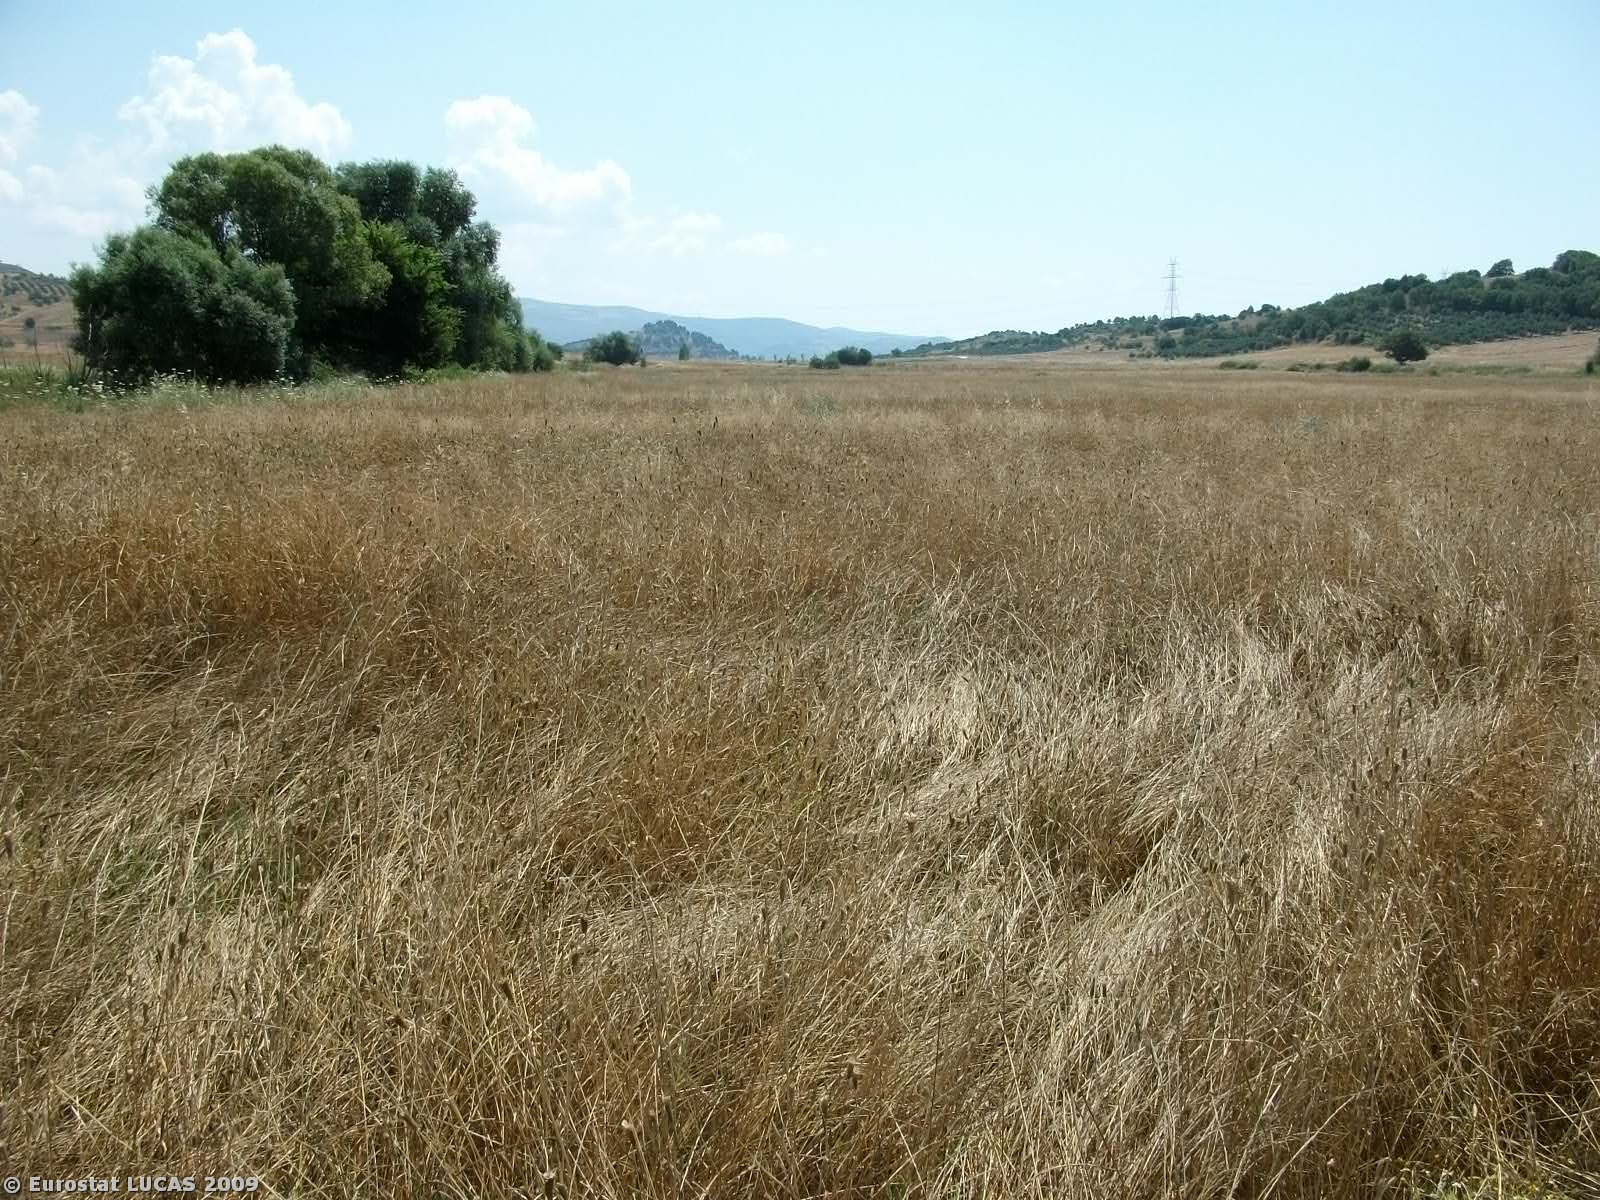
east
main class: Cropland
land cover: Common wheat
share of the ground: > 75 %
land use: Agriculture (excluding fallow land and kitchen gardens)
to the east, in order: Common wheat; Shruby margins; Ditches and canals; Shruby margins; Common wheat; Grass margins; Paved roads, cycling and walking lanes; Shruby margins; Ditches and canals; Common wheat
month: July
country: GR
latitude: 39.6743
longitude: 21.7006
